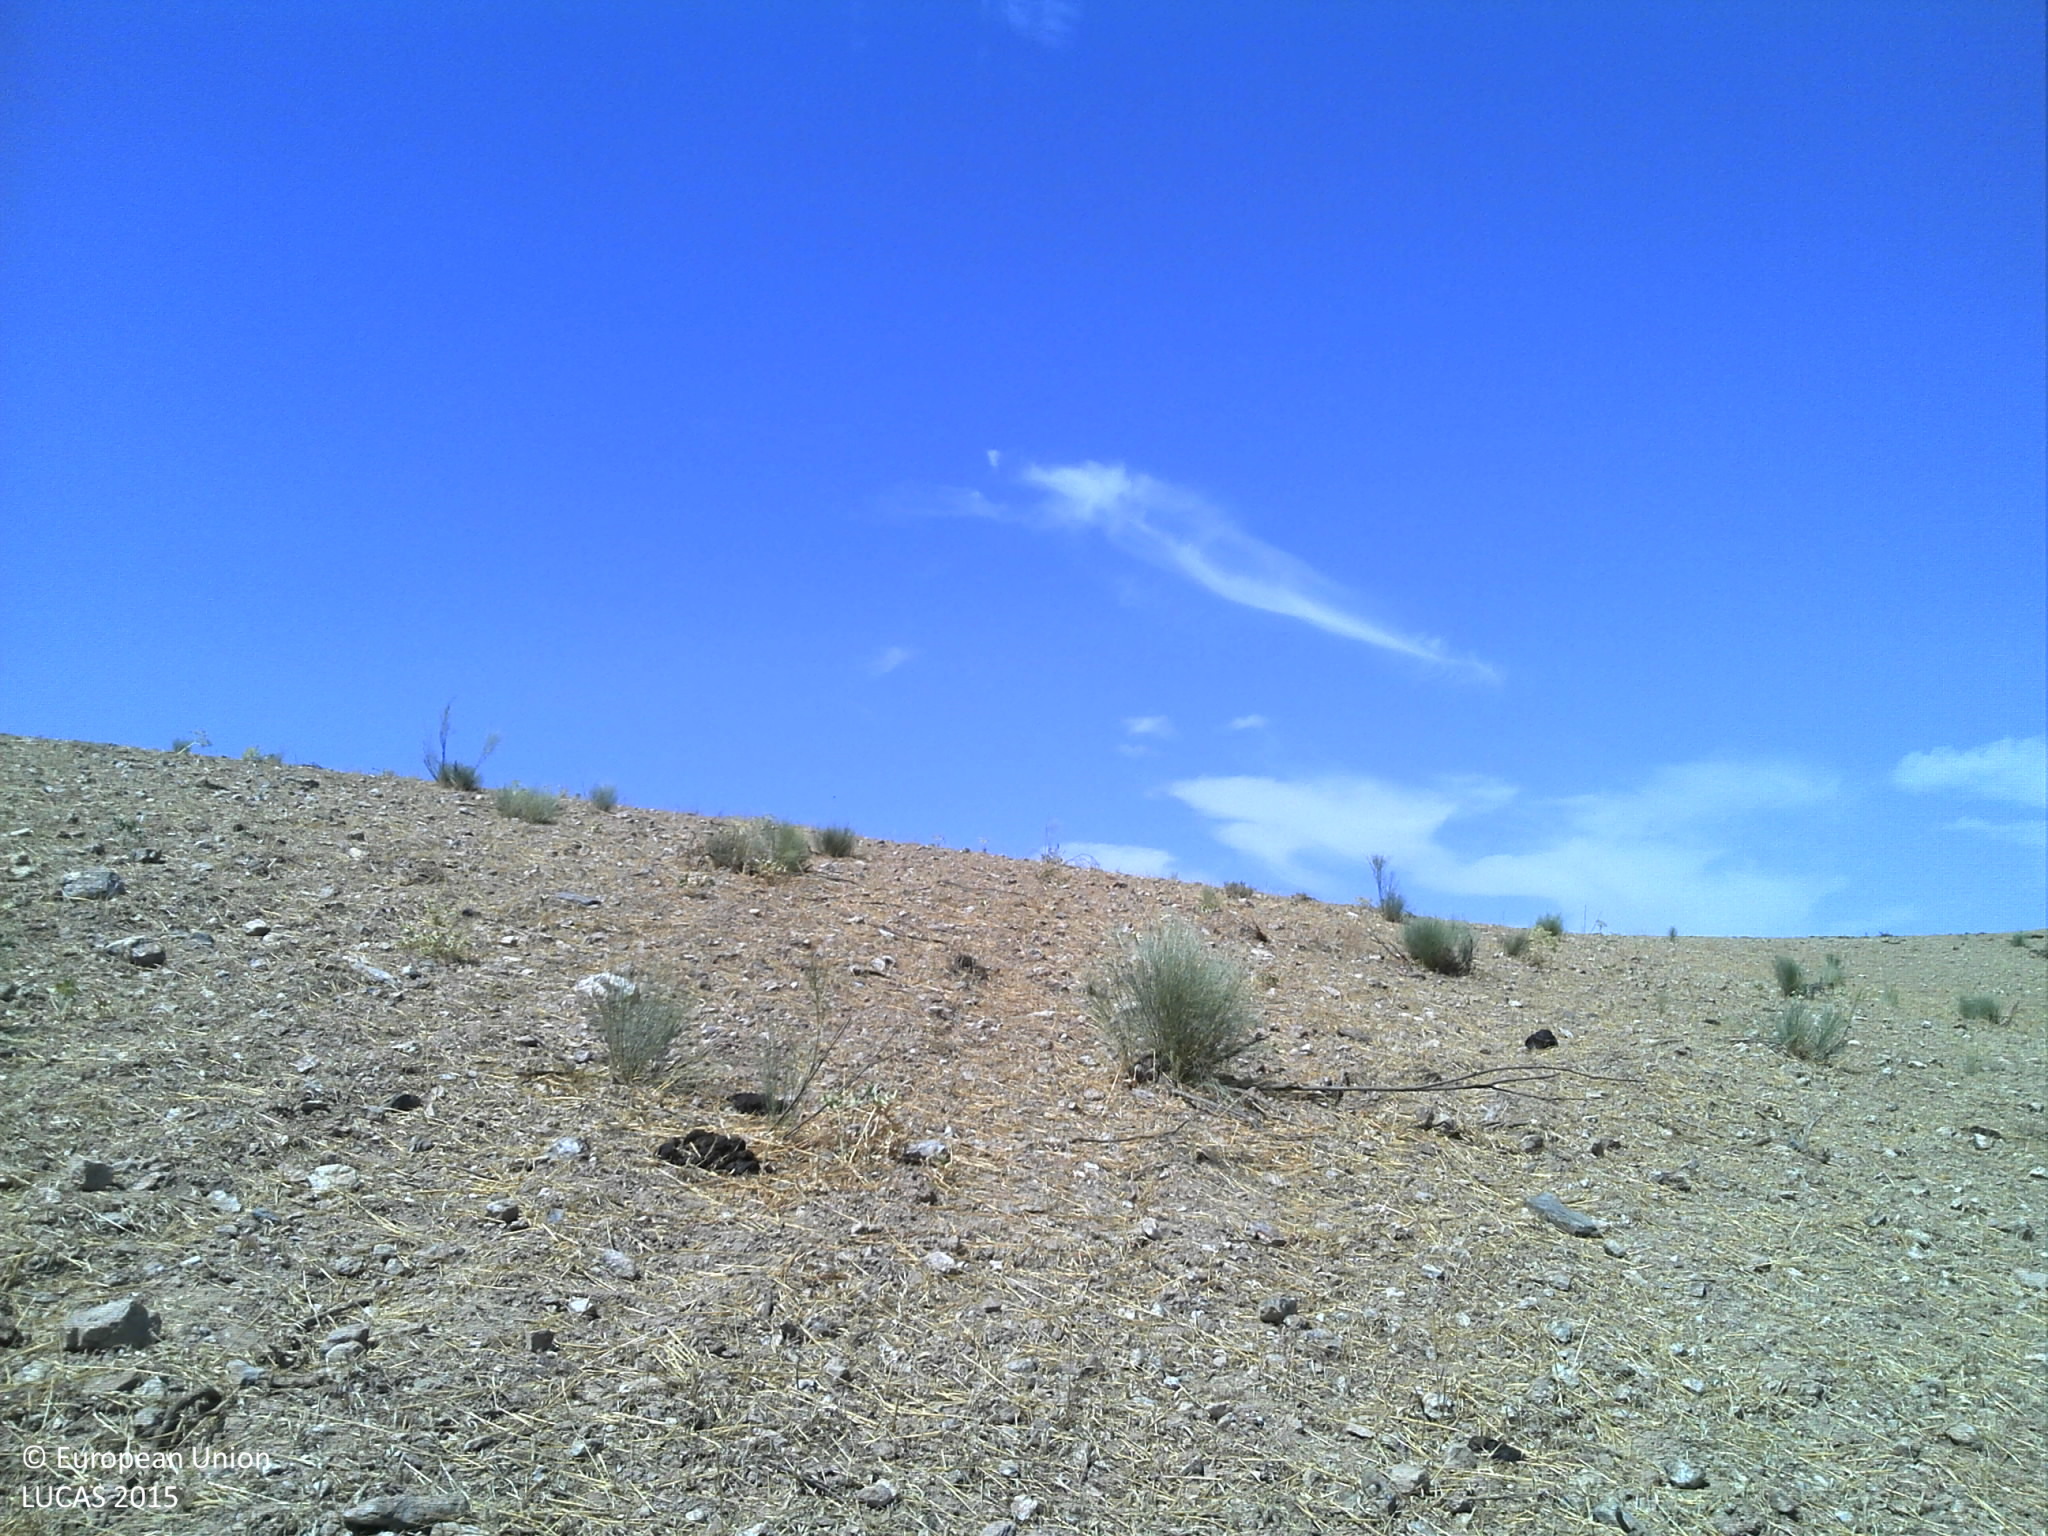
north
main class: Cropland
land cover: Oats
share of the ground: < 10 %
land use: Agriculture (excluding fallow land and kitchen gardens)
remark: Harvested field
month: July
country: PT
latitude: 38.4157
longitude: -7.6333
